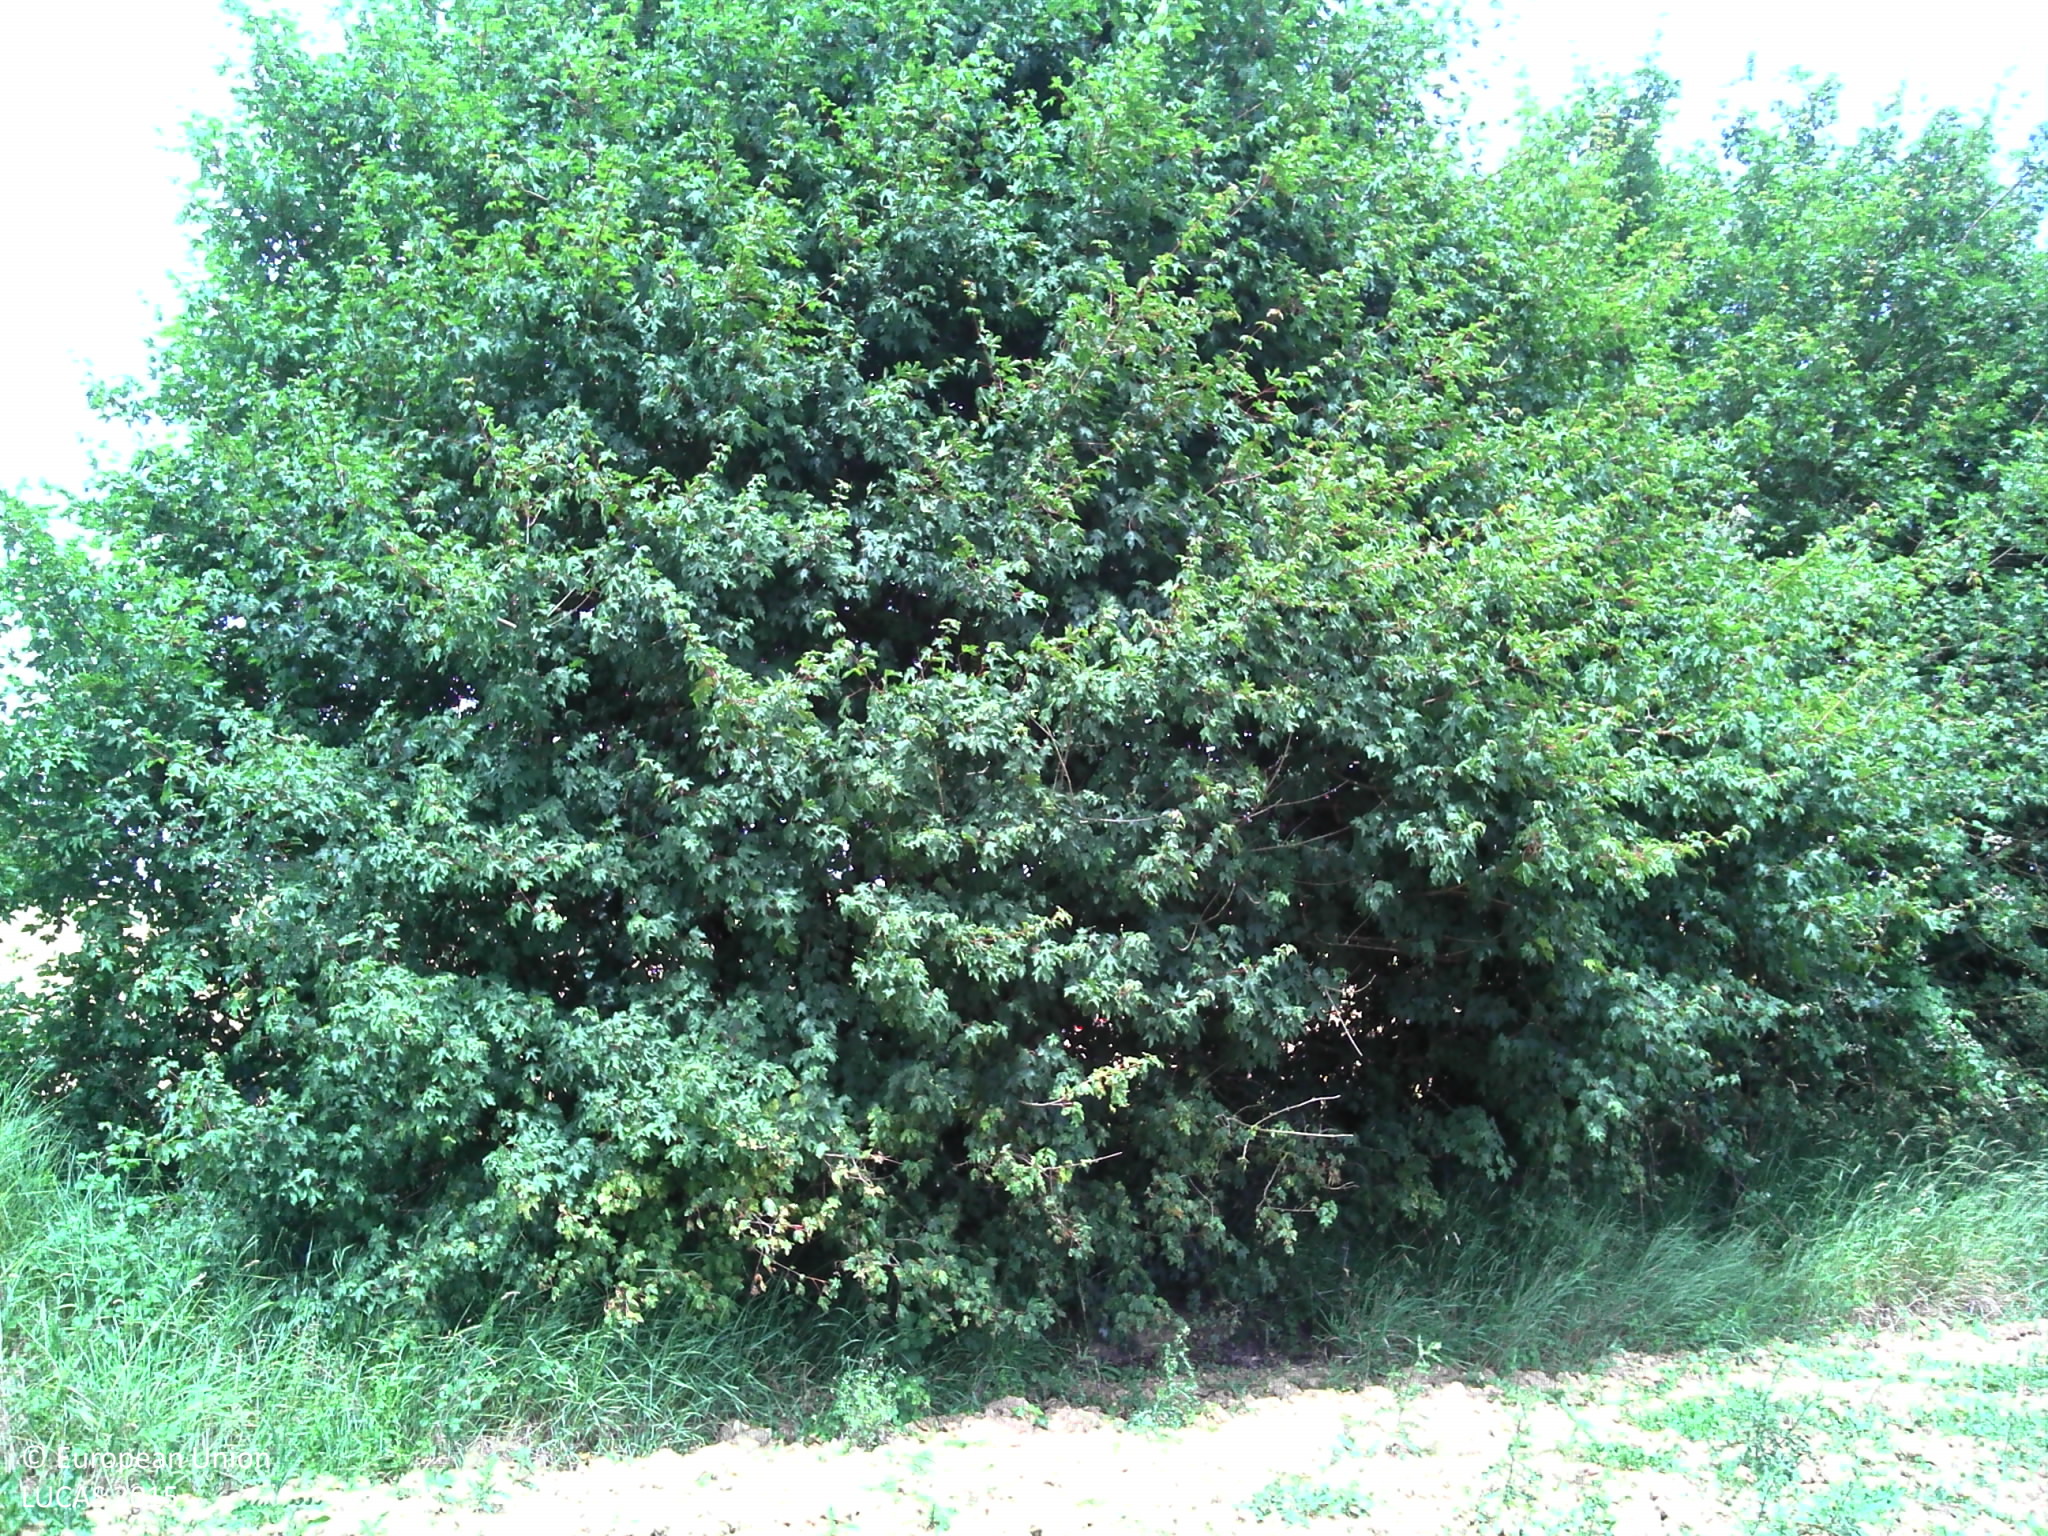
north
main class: Cropland
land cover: Sunflower
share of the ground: < 10 %
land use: Agriculture (excluding fallow land and kitchen gardens)
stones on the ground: > 50 %
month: June
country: FR
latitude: 48.3089
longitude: 0.1704
